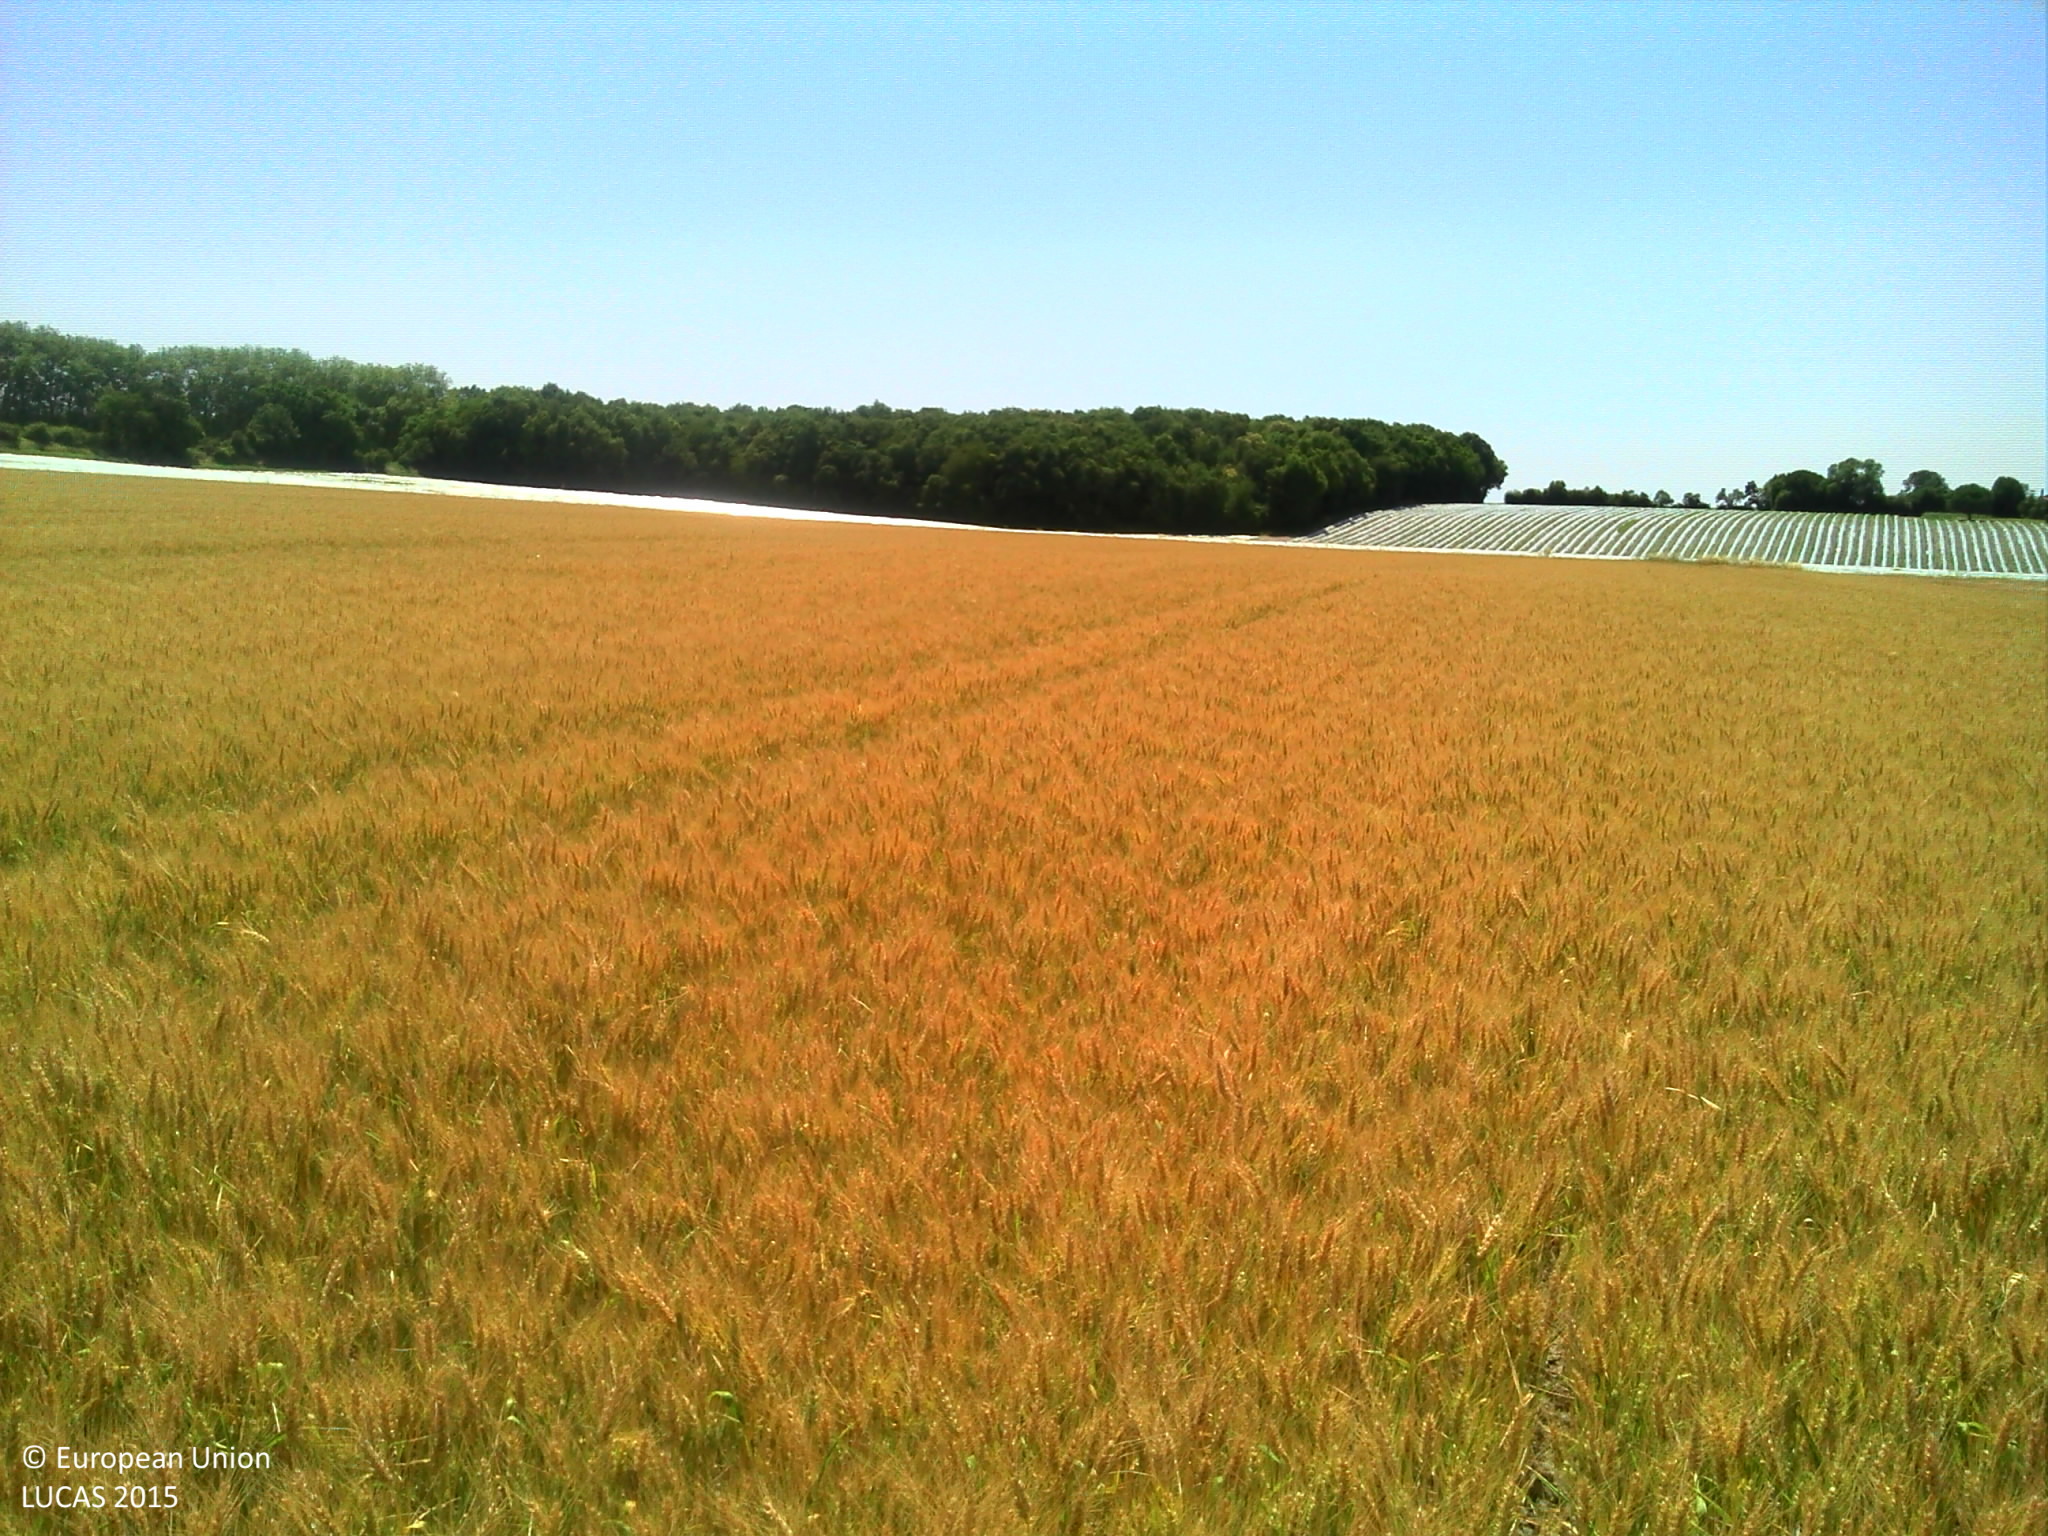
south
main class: Cropland
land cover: Durum wheat
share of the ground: > 75 %
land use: Agriculture (excluding fallow land and kitchen gardens)
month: June
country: FR
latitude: 45.5613
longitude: -0.8512
